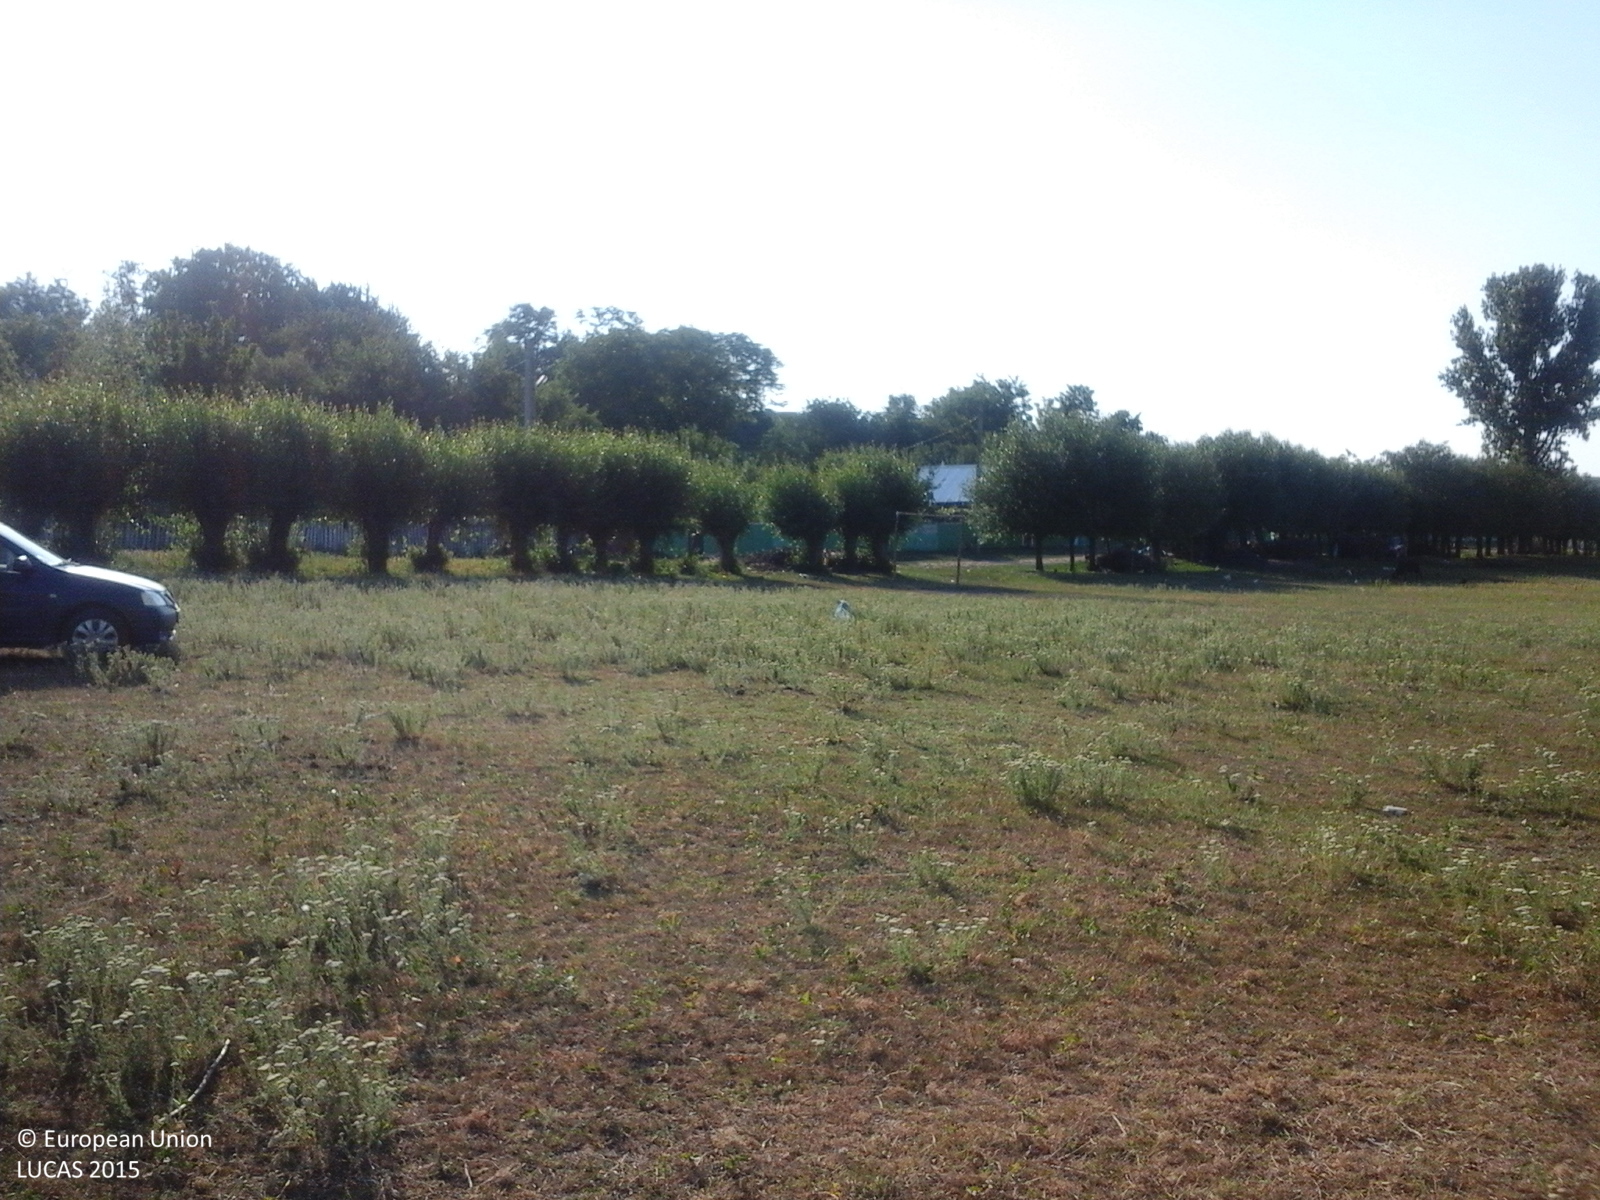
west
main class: Grassland
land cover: Grassland without tree/shrub cover
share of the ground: > 75 %
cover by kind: herbaceous plants 95 %, shrubs 5 %
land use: Agriculture (excluding fallow land and kitchen gardens)
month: June
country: RO
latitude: 46.7792
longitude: 27.8986
